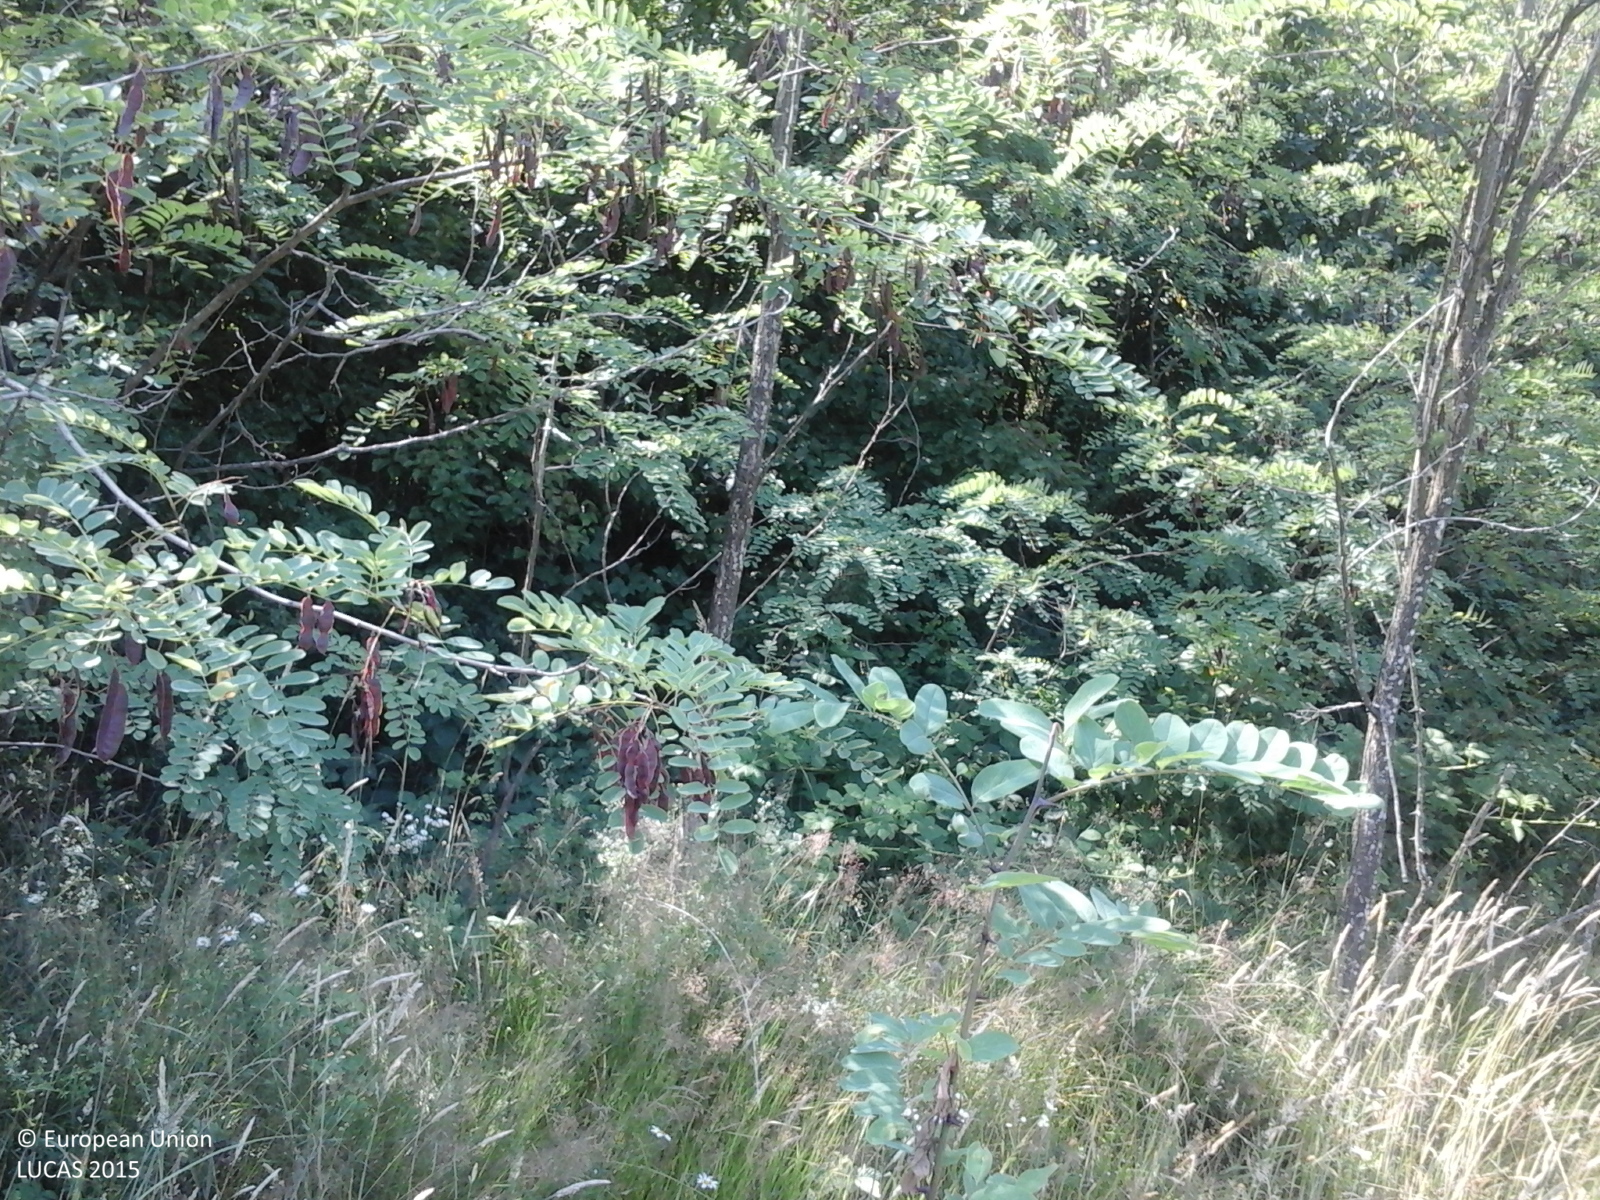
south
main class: Woodland
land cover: Broadleaved woodland
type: thermophilous deciduous forest
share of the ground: > 75 %
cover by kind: broadleaved forest trees 100 %
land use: Forestry
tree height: > 5 m
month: July
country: RO
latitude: 44.8397
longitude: 24.5344
